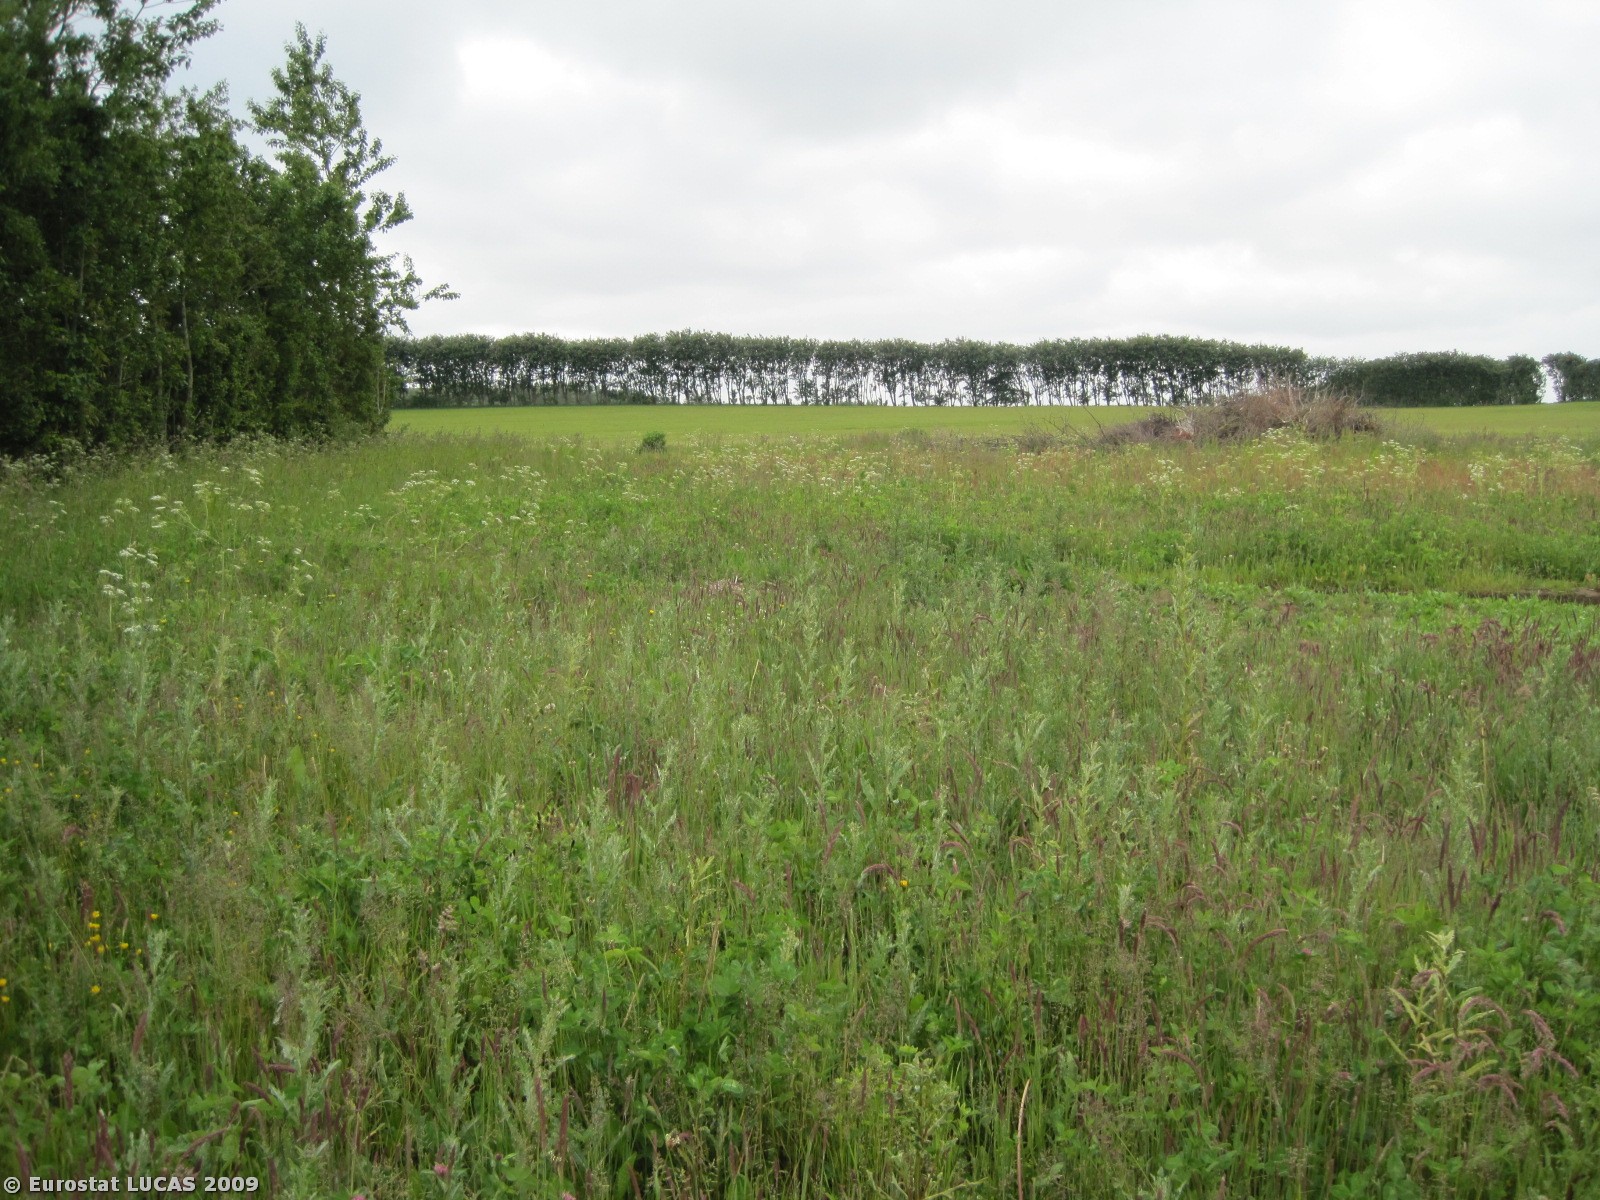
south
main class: Grassland
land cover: Grassland without tree/shrub cover
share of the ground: > 75 %
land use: Unused
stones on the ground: < 10 %
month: June
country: DK
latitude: 57.2124
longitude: 10.1157
